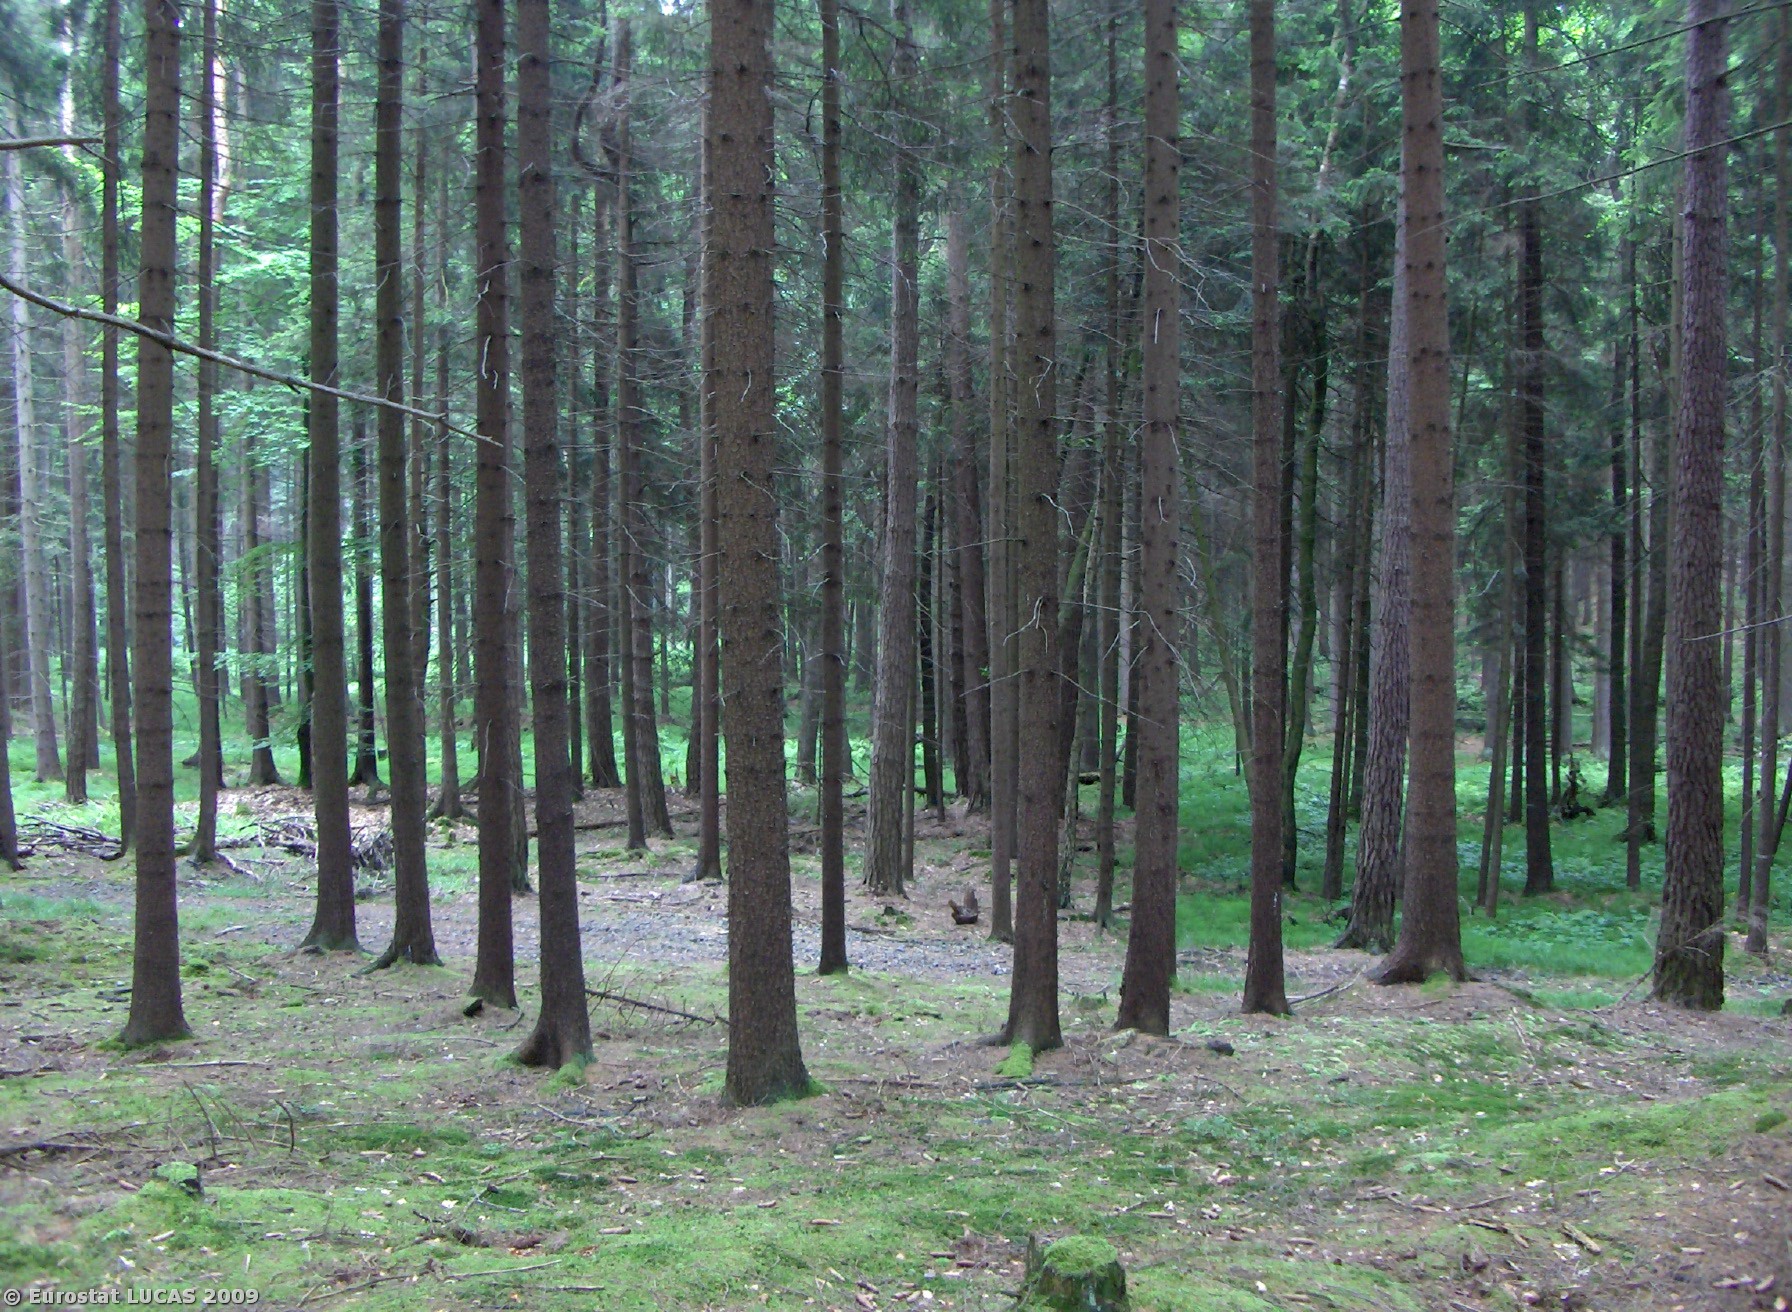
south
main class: Woodland
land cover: Coniferous woodland
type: hemiboreal forest and nemoral coniferous forest and mixed broadleaved-coniferous forest
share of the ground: > 75 %
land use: Forestry
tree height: > 5 m
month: July
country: CZ
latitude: 49.3562
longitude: 12.8771
